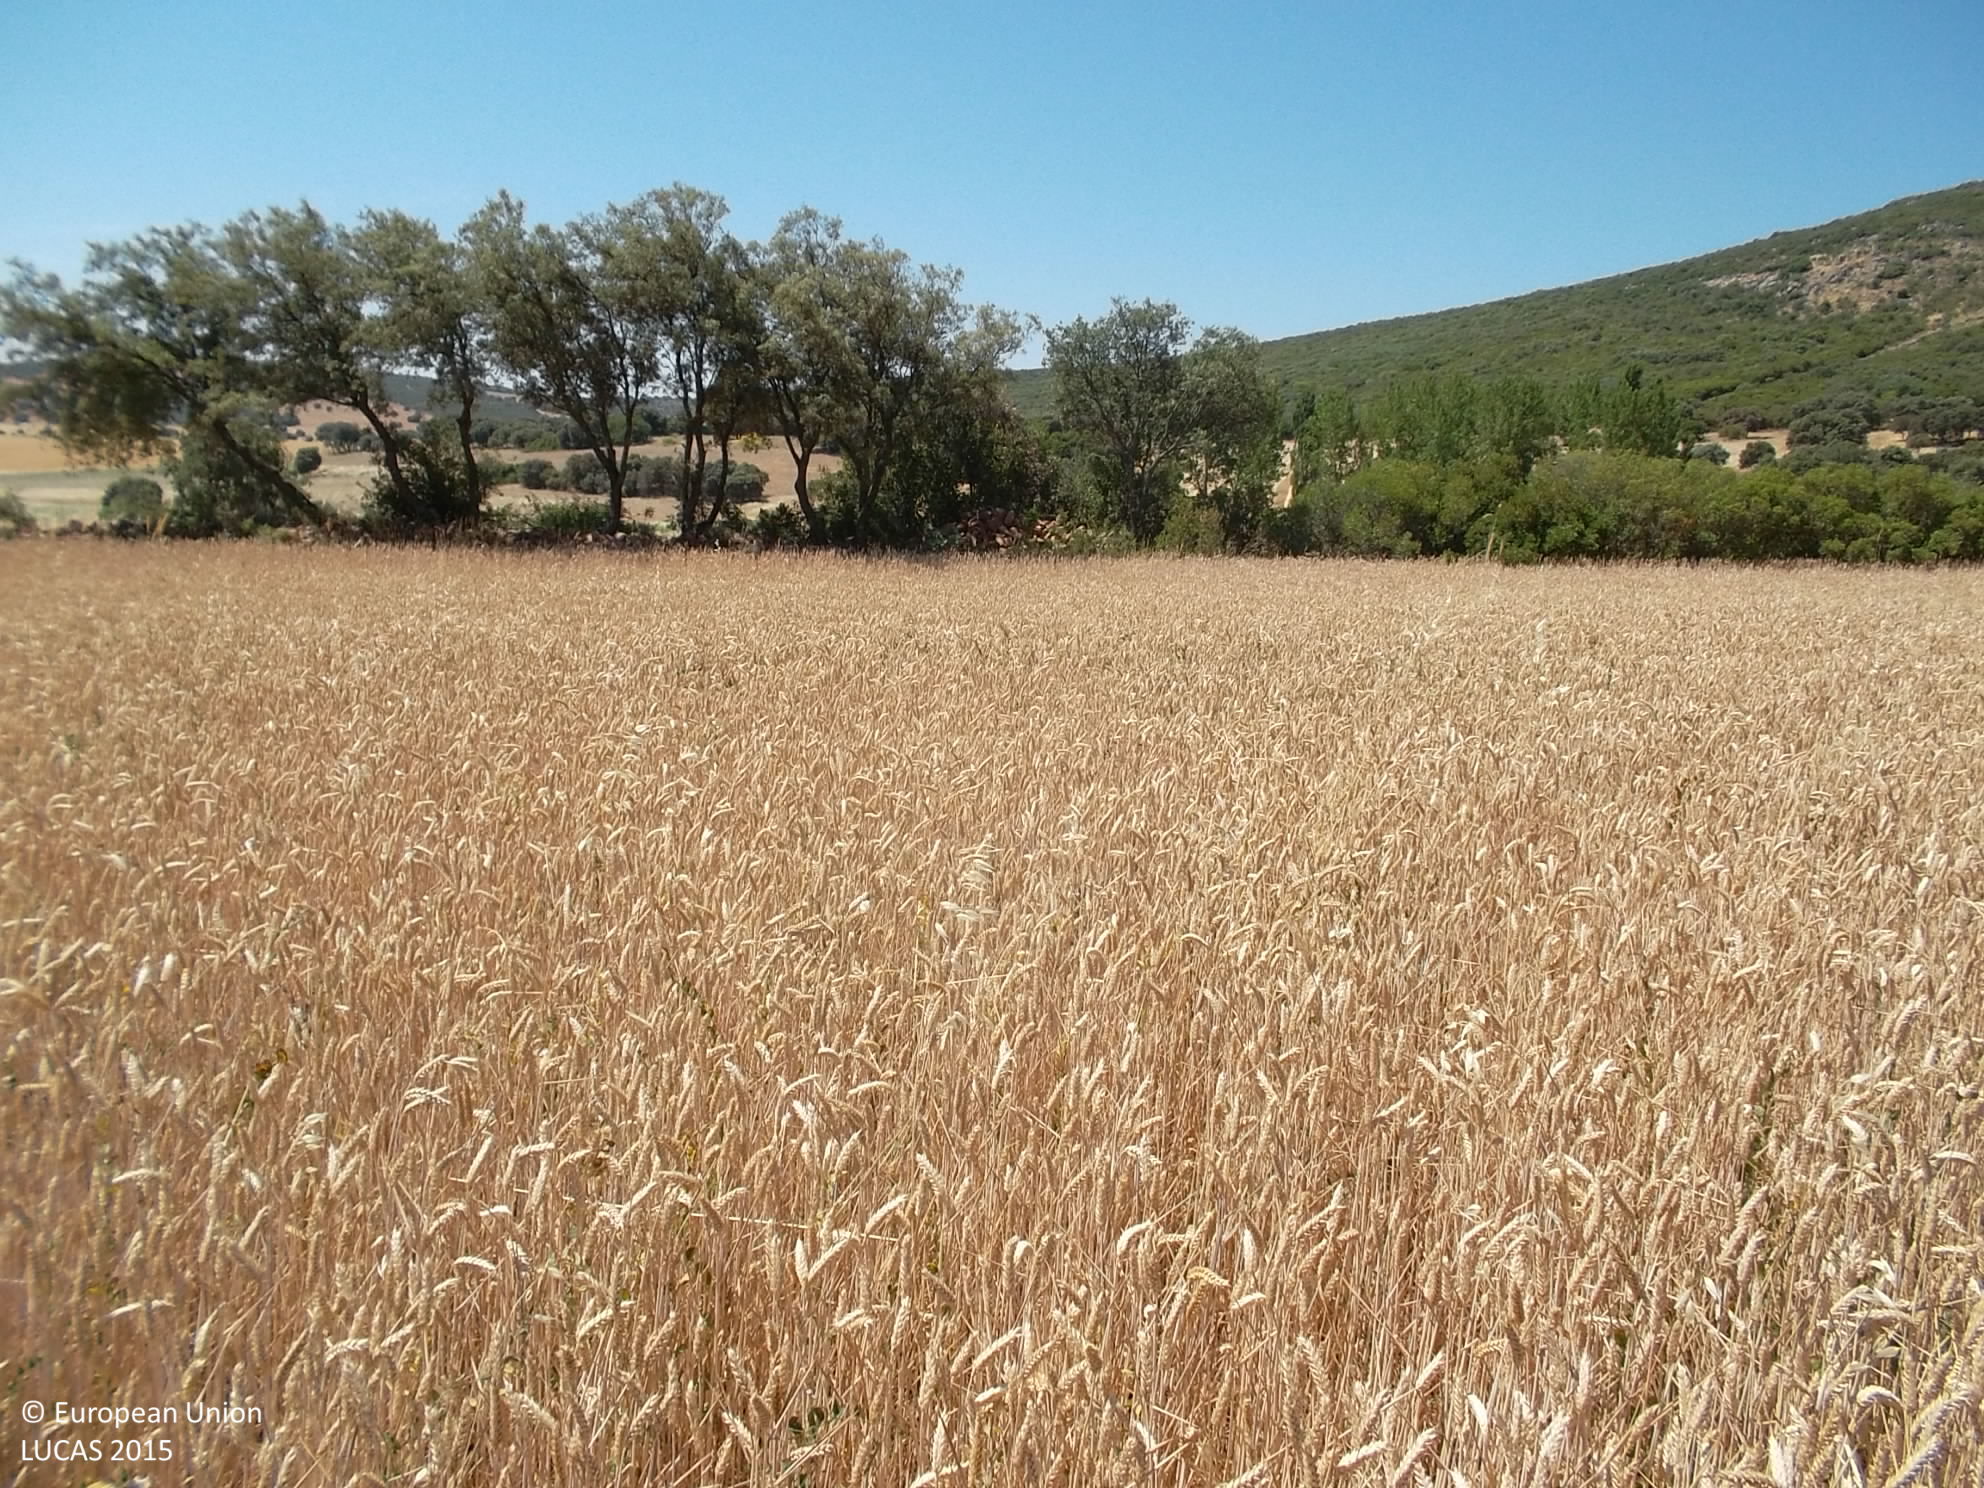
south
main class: Cropland
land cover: Common wheat
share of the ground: > 75 %
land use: Agriculture (excluding fallow land and kitchen gardens)
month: June
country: ES
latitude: 39.0617
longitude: -4.0882
